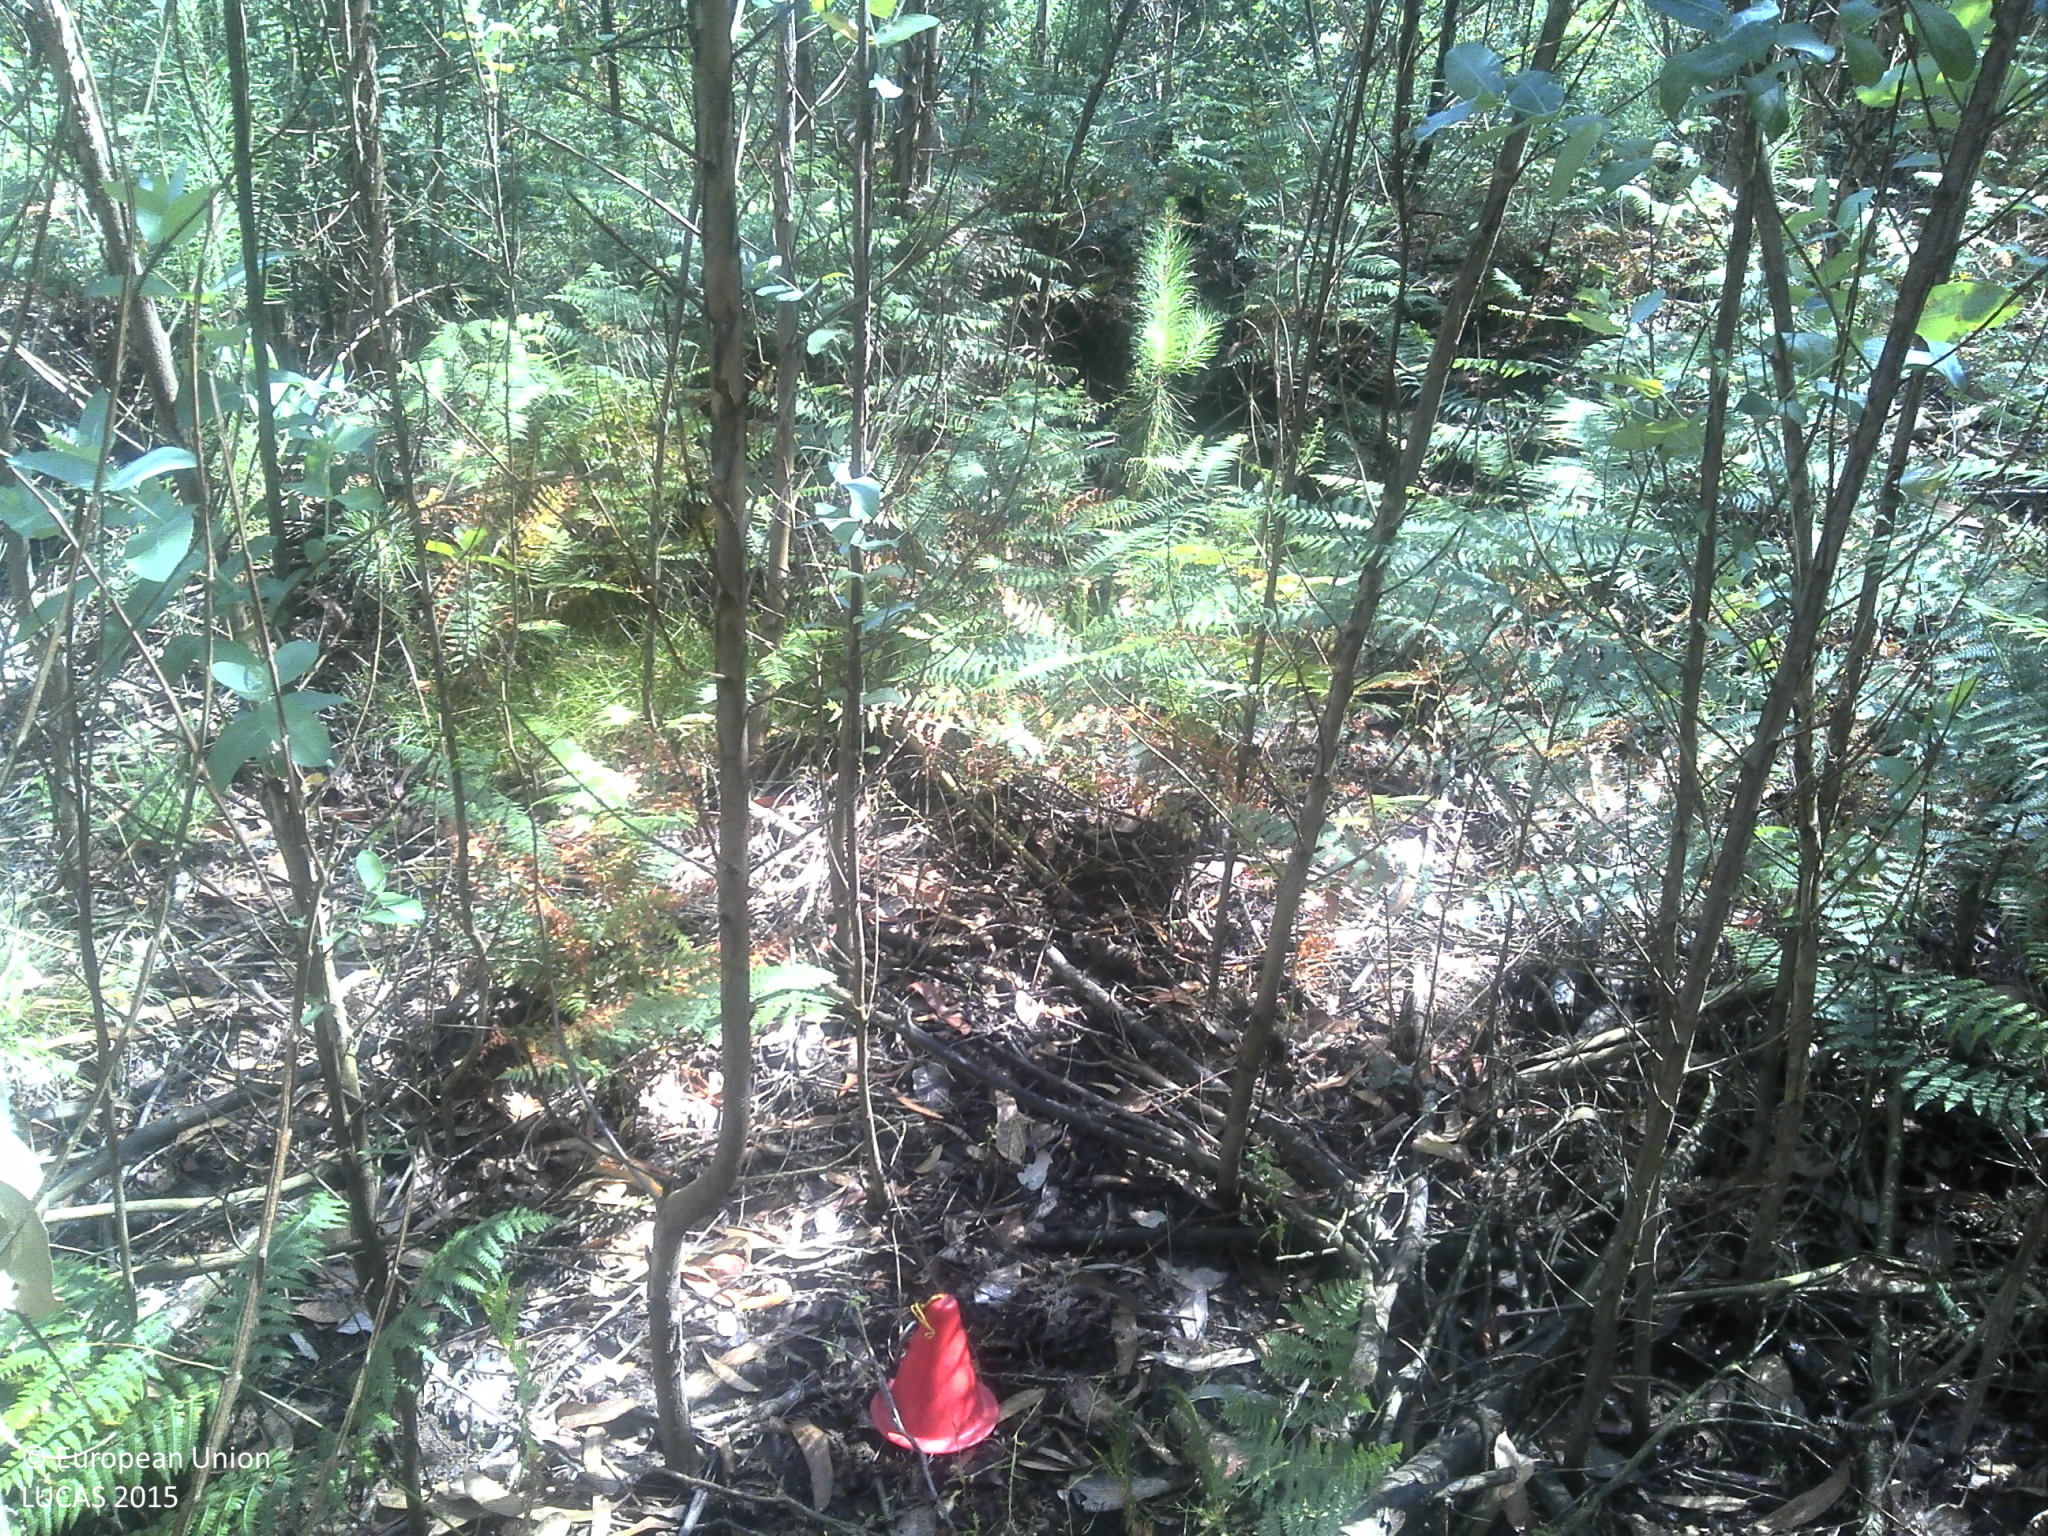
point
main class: Woodland
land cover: Broadleaved woodland
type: exotic forest
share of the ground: > 75 %
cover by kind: broadleaved forest trees 80 %, shrubs 15 %, unconsolidated bare surface 5 %
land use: Forestry
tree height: > 5 m
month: June
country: PT
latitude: 41.6057
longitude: -8.6520
